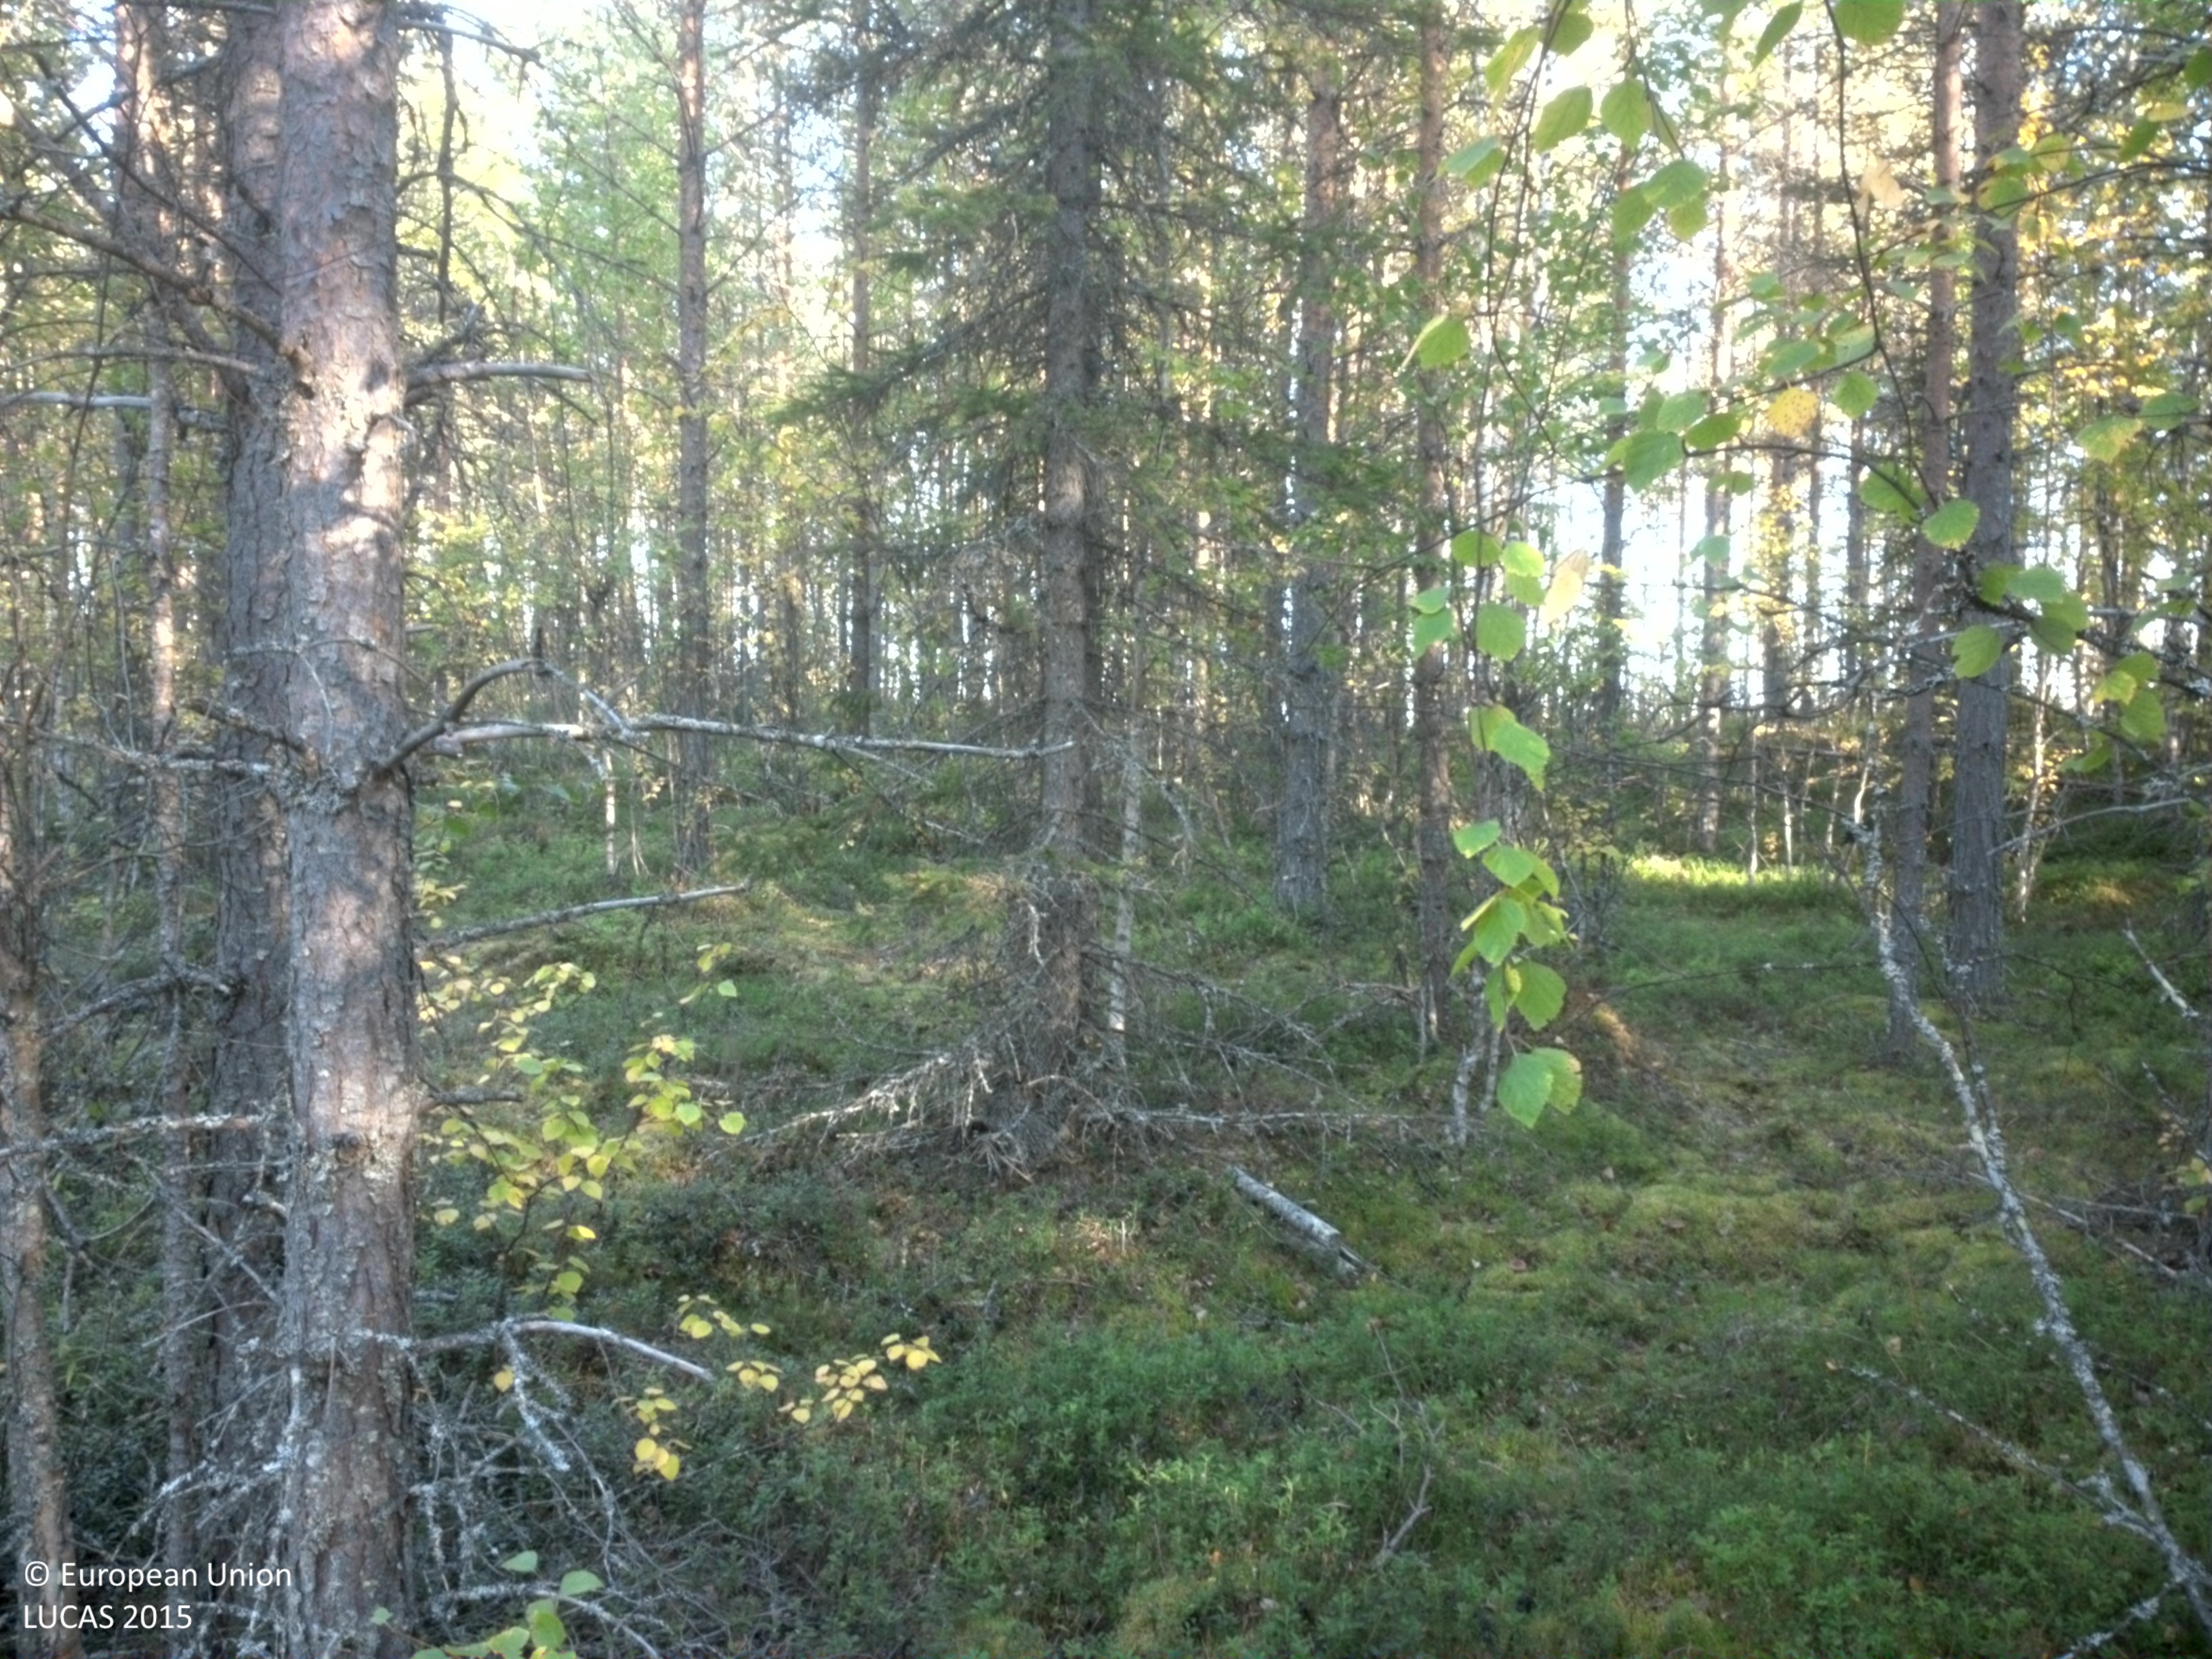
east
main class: Woodland
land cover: Pine dominated mixed woodland
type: boreal forest
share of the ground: 50 - 75 %
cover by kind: coniferous forest trees 45 %, shrubs 30 %, broadleaved forest trees 15 %, lichens and mosses 10 %
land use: Forestry
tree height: > 5 m
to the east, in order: Pine dominated mixed woodland; Shrubland with sparse tree cover; Other bare soil; Shrubland without tree cover; Single bushes/trees; Shrubland without tree cover
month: September
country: SE
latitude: 64.3719
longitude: 19.7337
